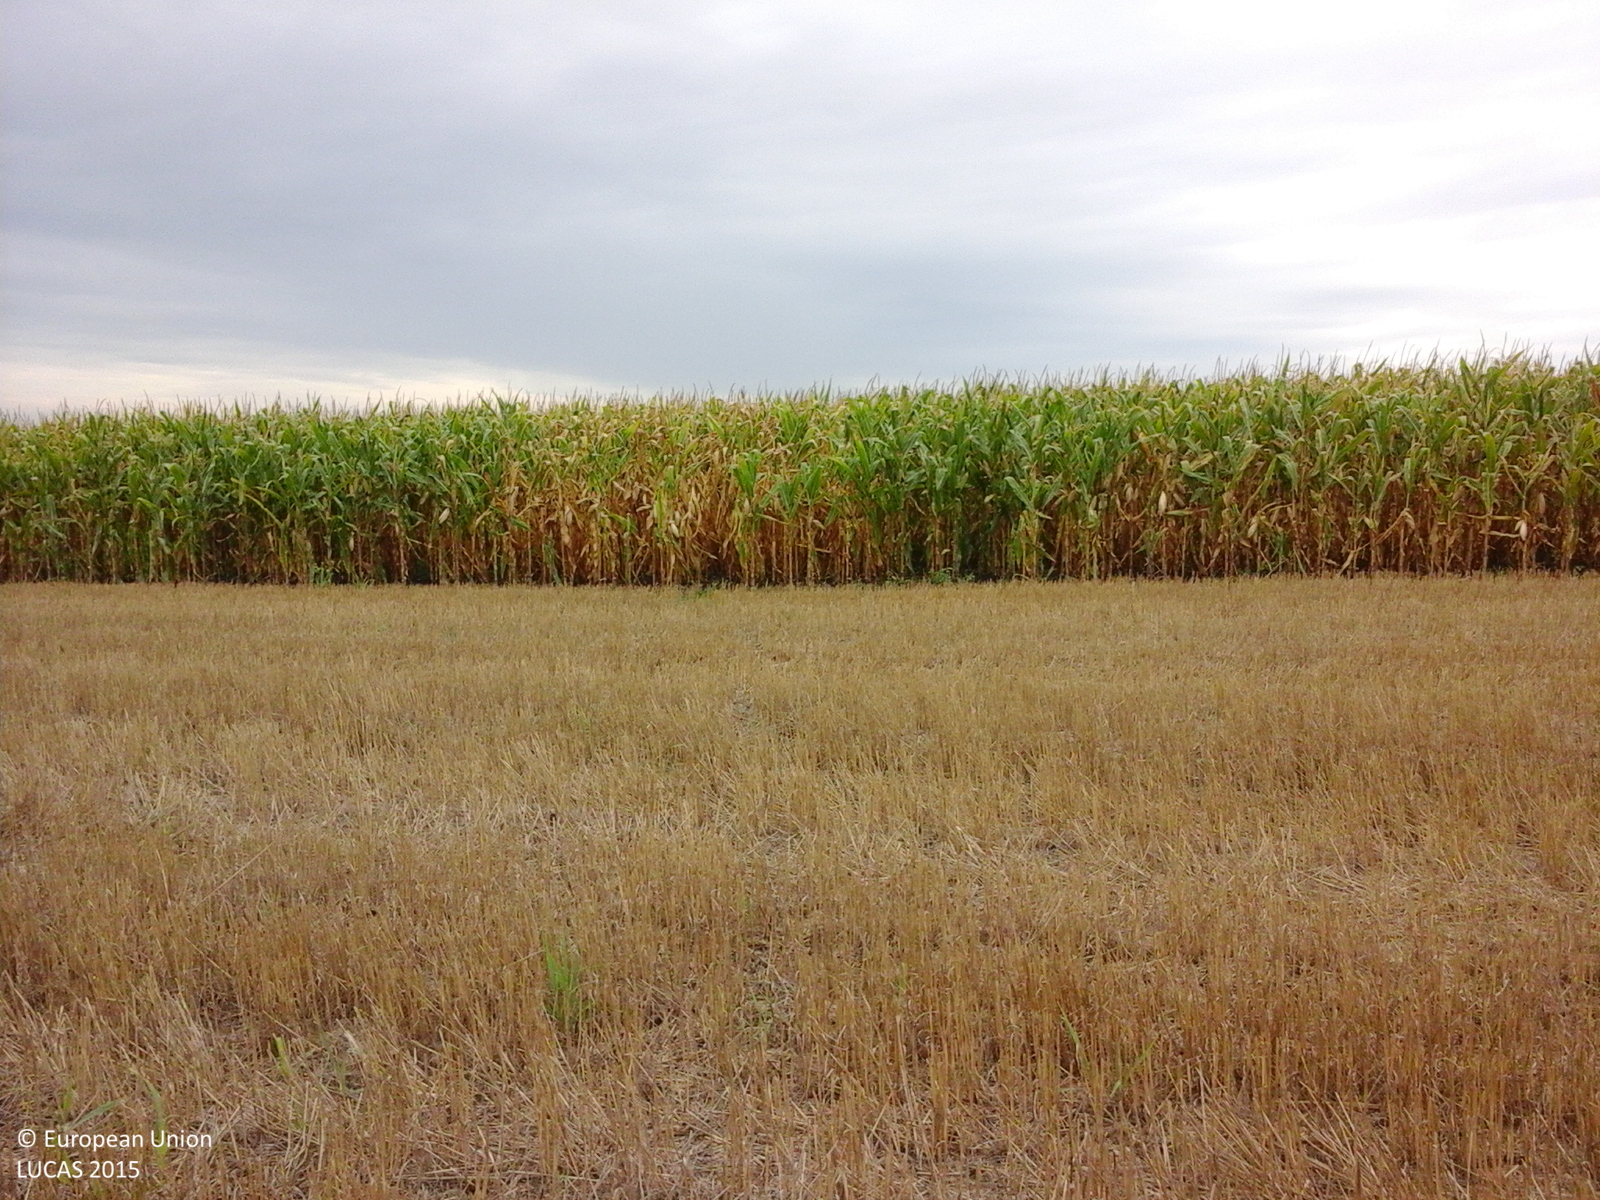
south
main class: Cropland
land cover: Maize
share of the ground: > 75 %
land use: Agriculture (excluding fallow land and kitchen gardens)
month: August
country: RO
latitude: 45.8566
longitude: 20.8064
